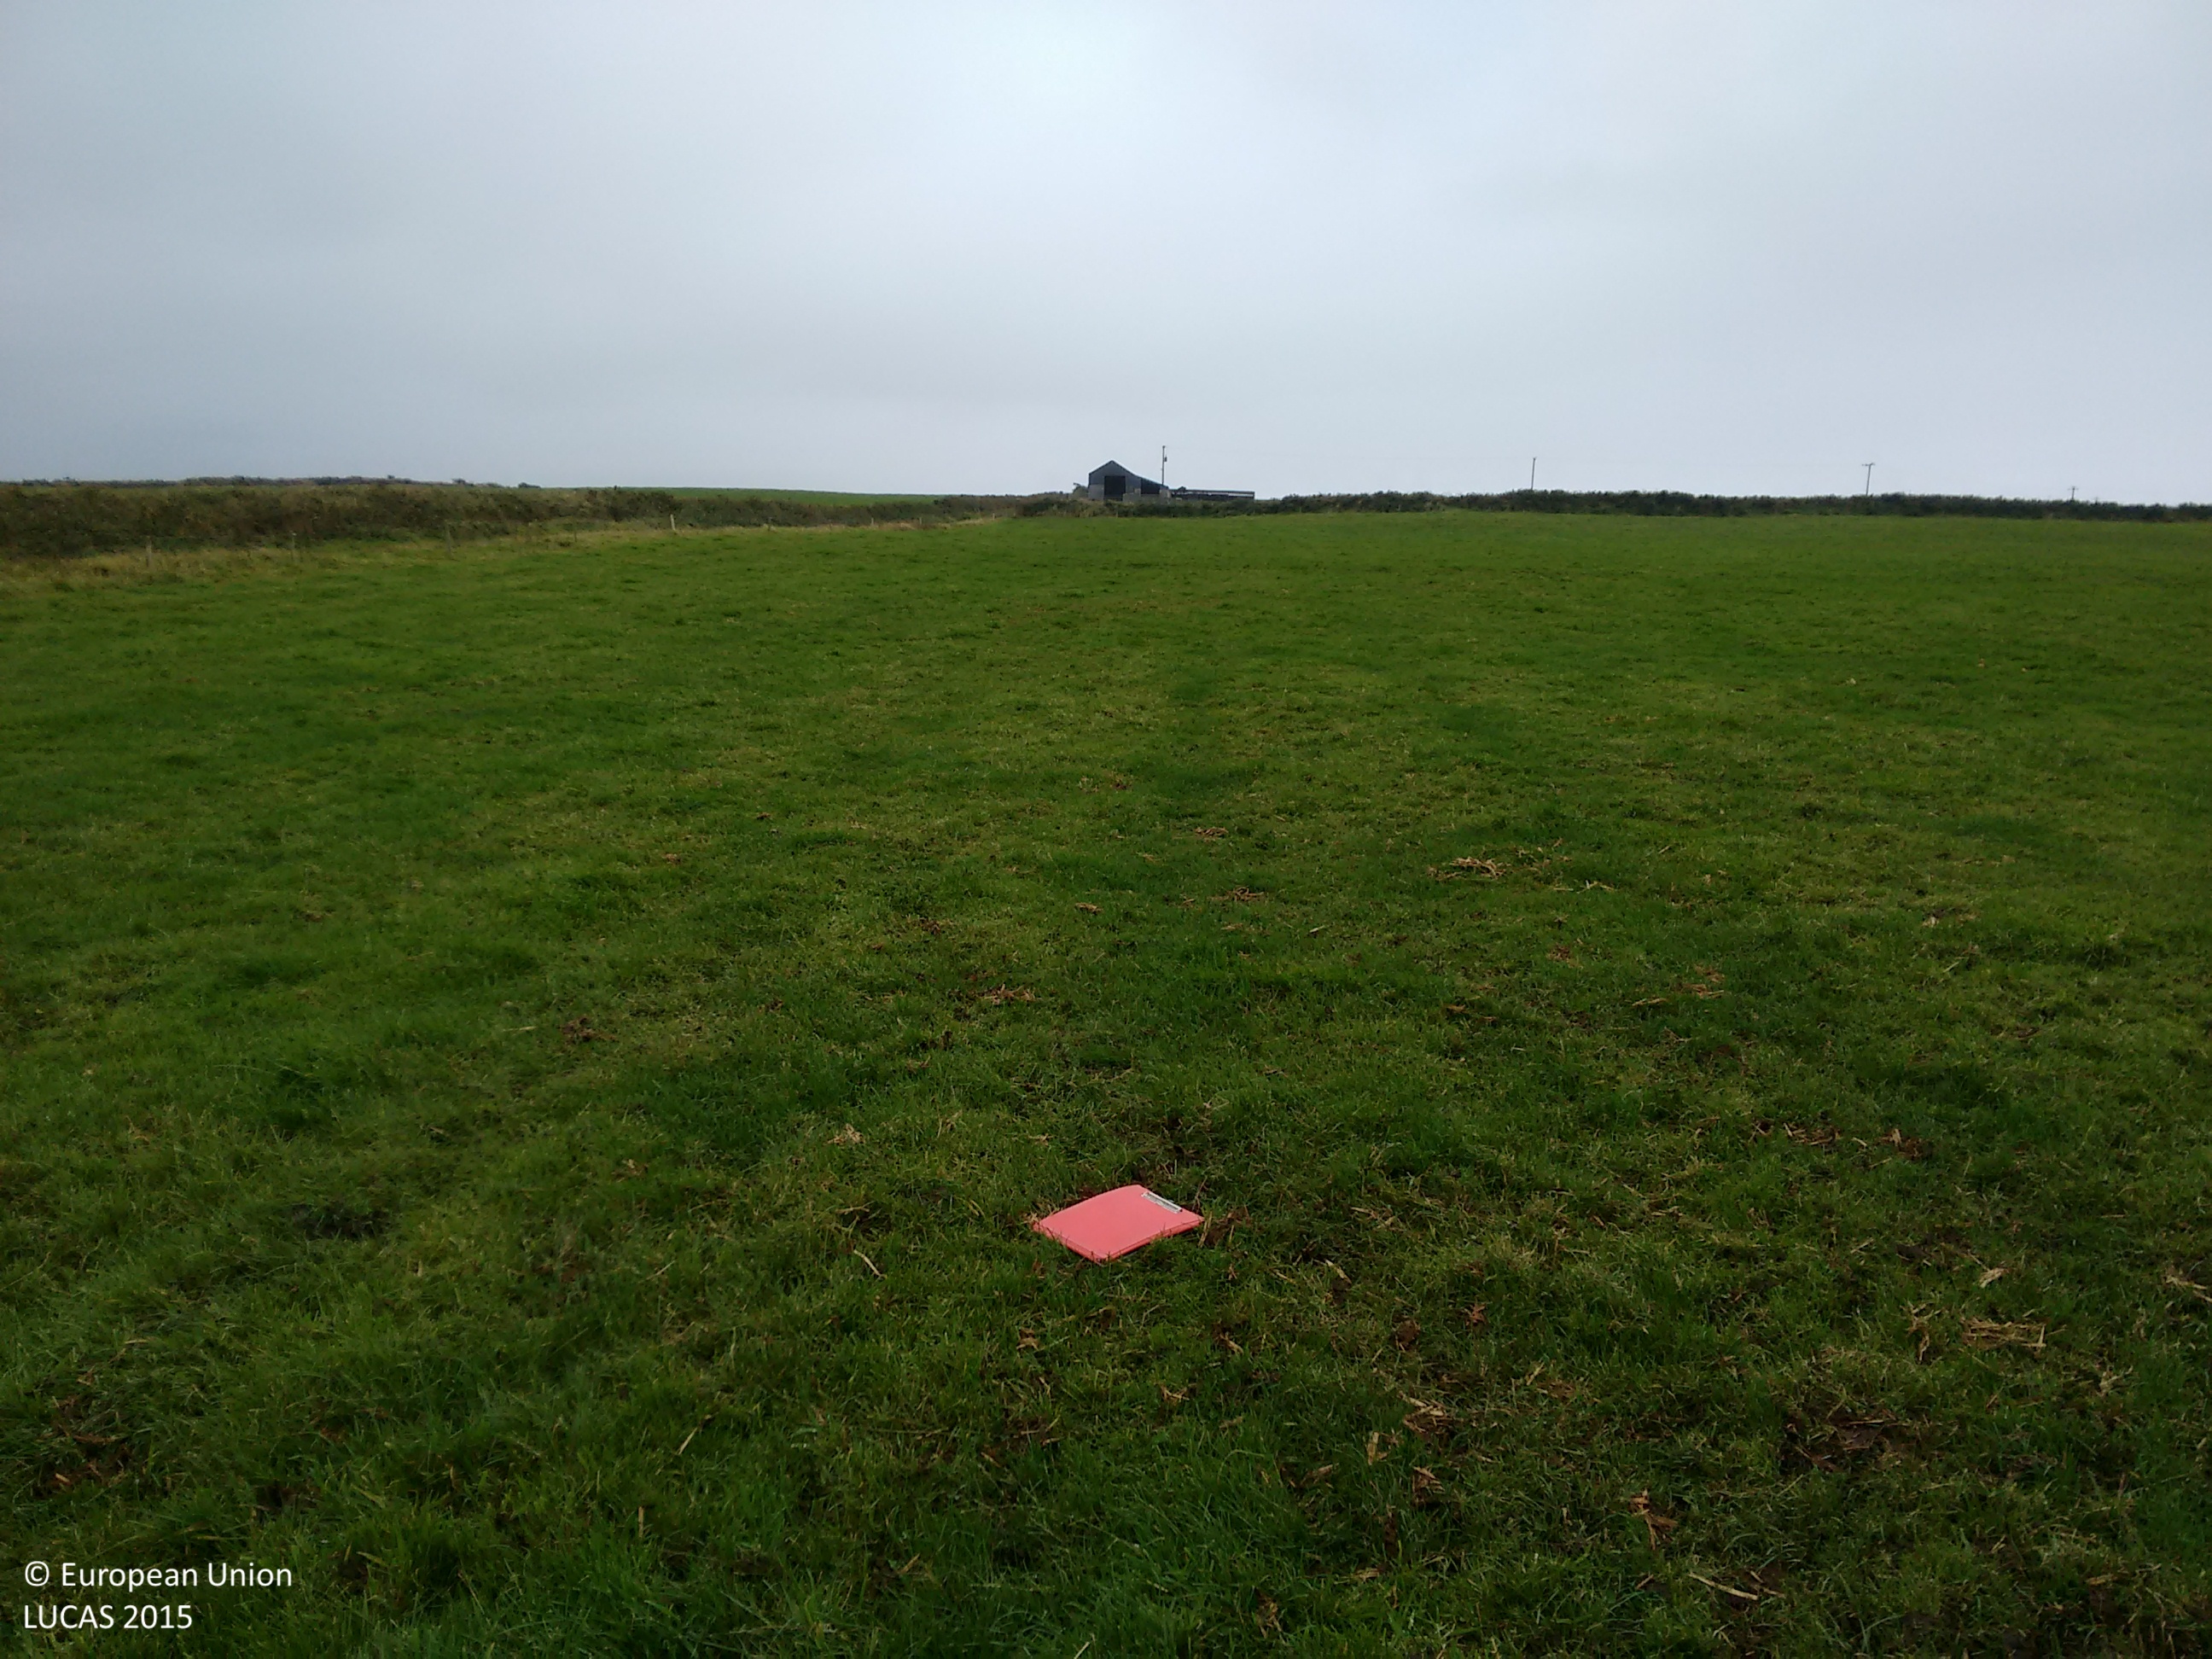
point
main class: Grassland
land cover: Grassland without tree/shrub cover
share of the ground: > 75 %
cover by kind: herbaceous plants 95 %, unconsolidated bare surface 5 %
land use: Agriculture (excluding fallow land and kitchen gardens)
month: September
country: IE
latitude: 52.7014
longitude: -9.6089
